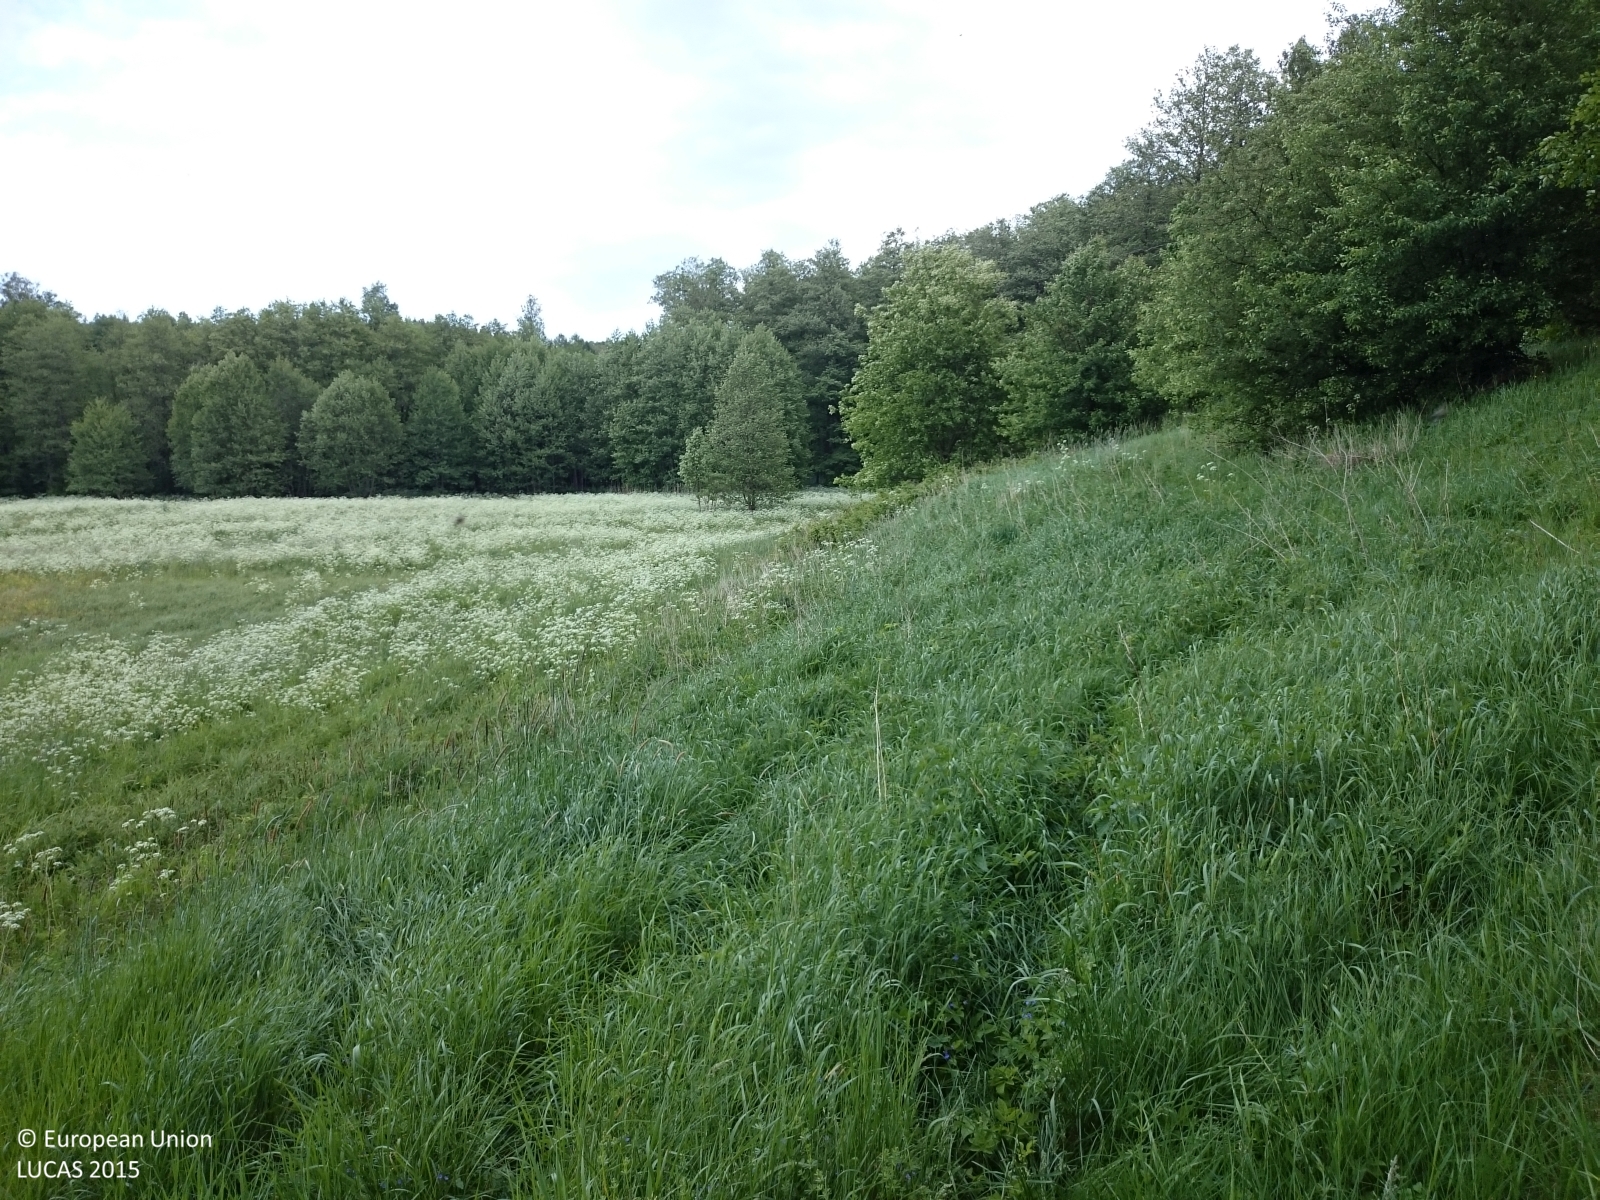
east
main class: Grassland
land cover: Grassland with sparse tree/shrub cover
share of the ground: > 75 %
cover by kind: herbaceous plants 95 %, broadleaved forest trees 5 %
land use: Semi-natural and natural areas not in use
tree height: < 5 m
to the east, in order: Grassland with sparse tree/shrub cover; Broadleaved woodland; Fences; Broadleaved woodland
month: March
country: PL
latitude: 53.0240
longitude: 16.2530
